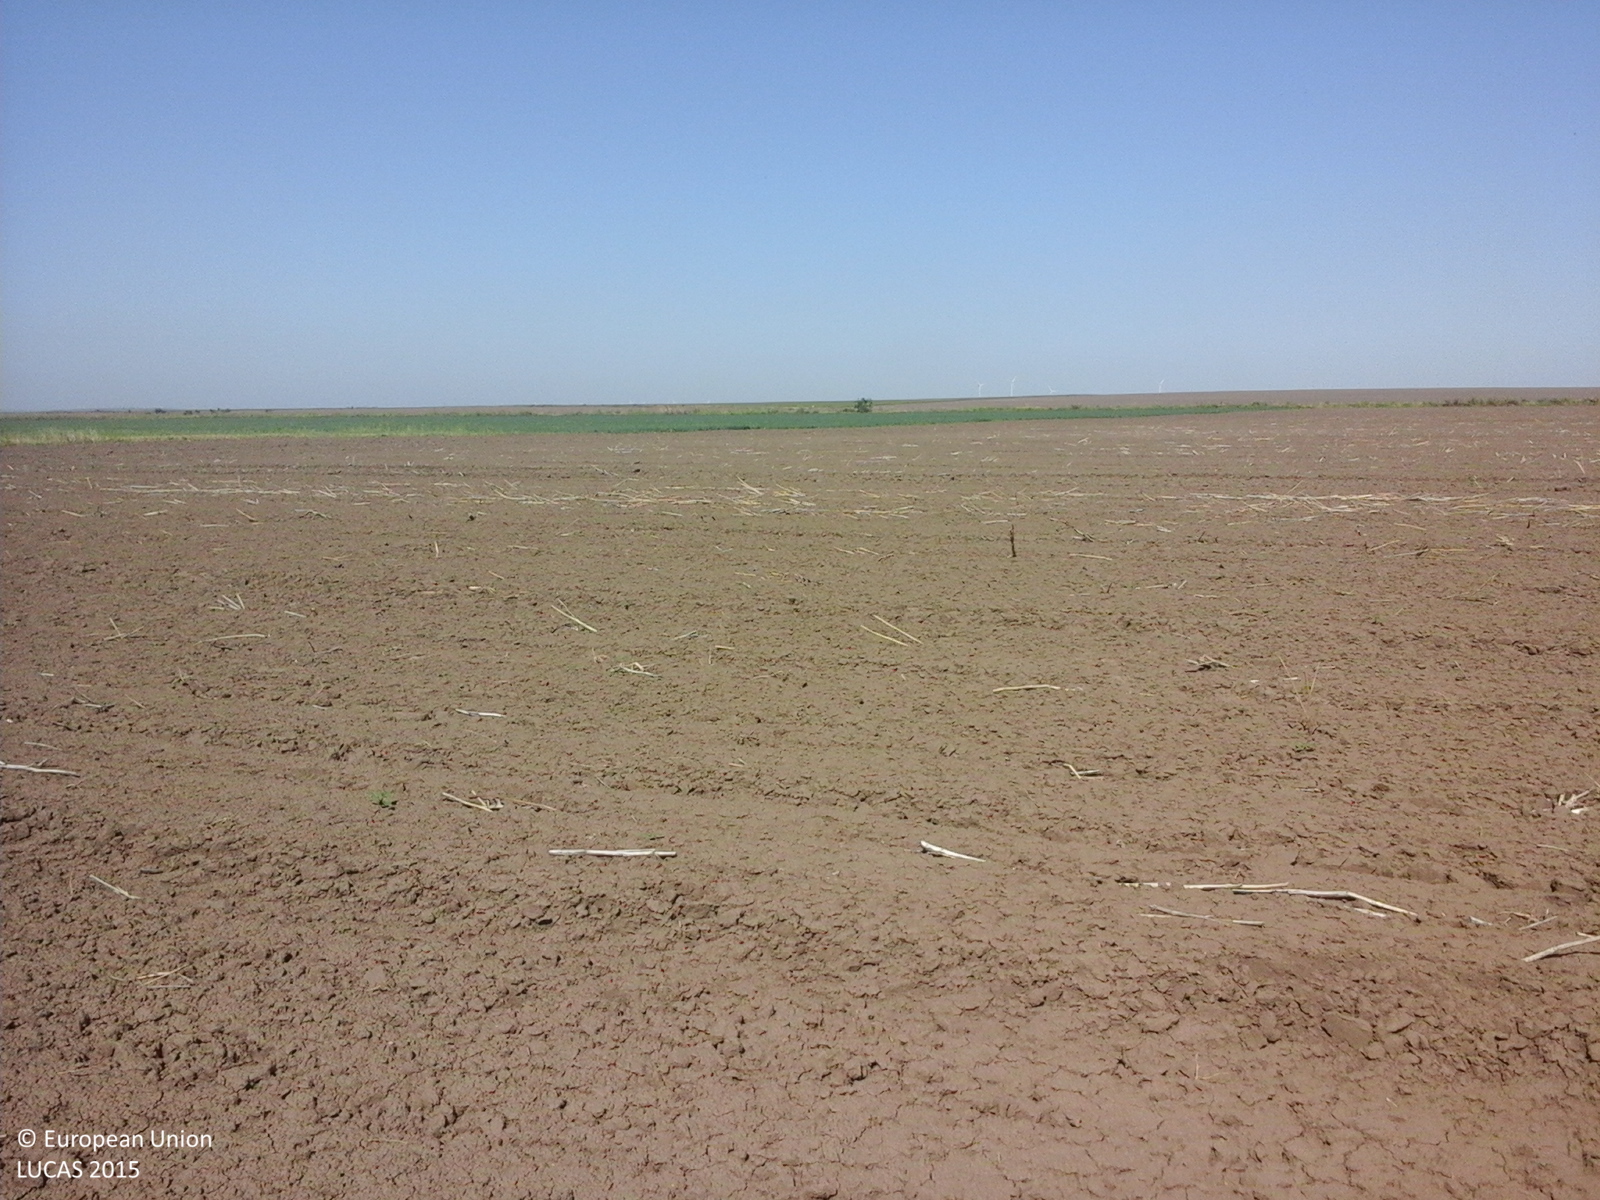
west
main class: Cropland
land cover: Rape and turnip rape
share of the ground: < 10 %
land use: Agriculture (excluding fallow land and kitchen gardens)
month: August
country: RO
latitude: 44.3151
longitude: 28.3846
